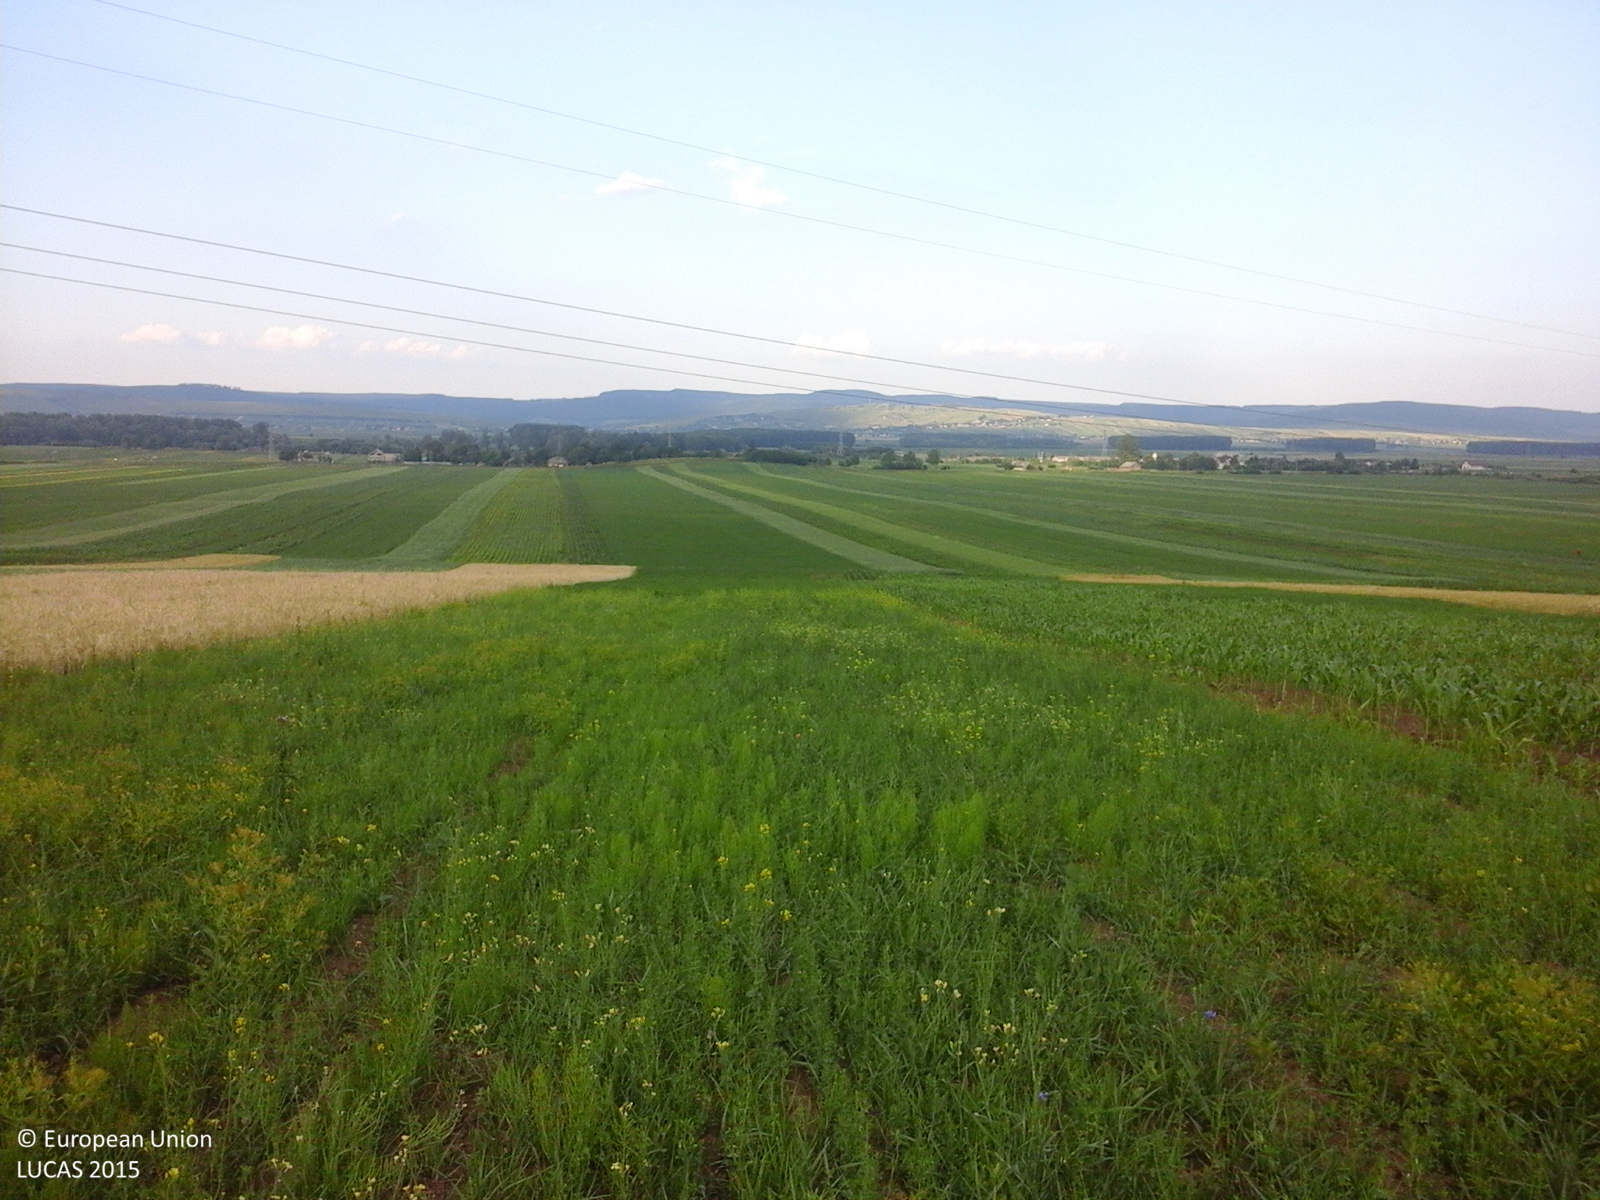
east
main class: Cropland
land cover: Other leguminous and mixtures for fodder
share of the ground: > 75 %
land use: Agriculture (excluding fallow land and kitchen gardens)
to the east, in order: Other leguminous and mixtures for fodder; Electric lines; Other leguminous and mixtures for fodder; Lucerne; Maize; Tracks; Lucerne; Oats
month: June
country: RO
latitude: 47.4957
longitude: 26.5365
